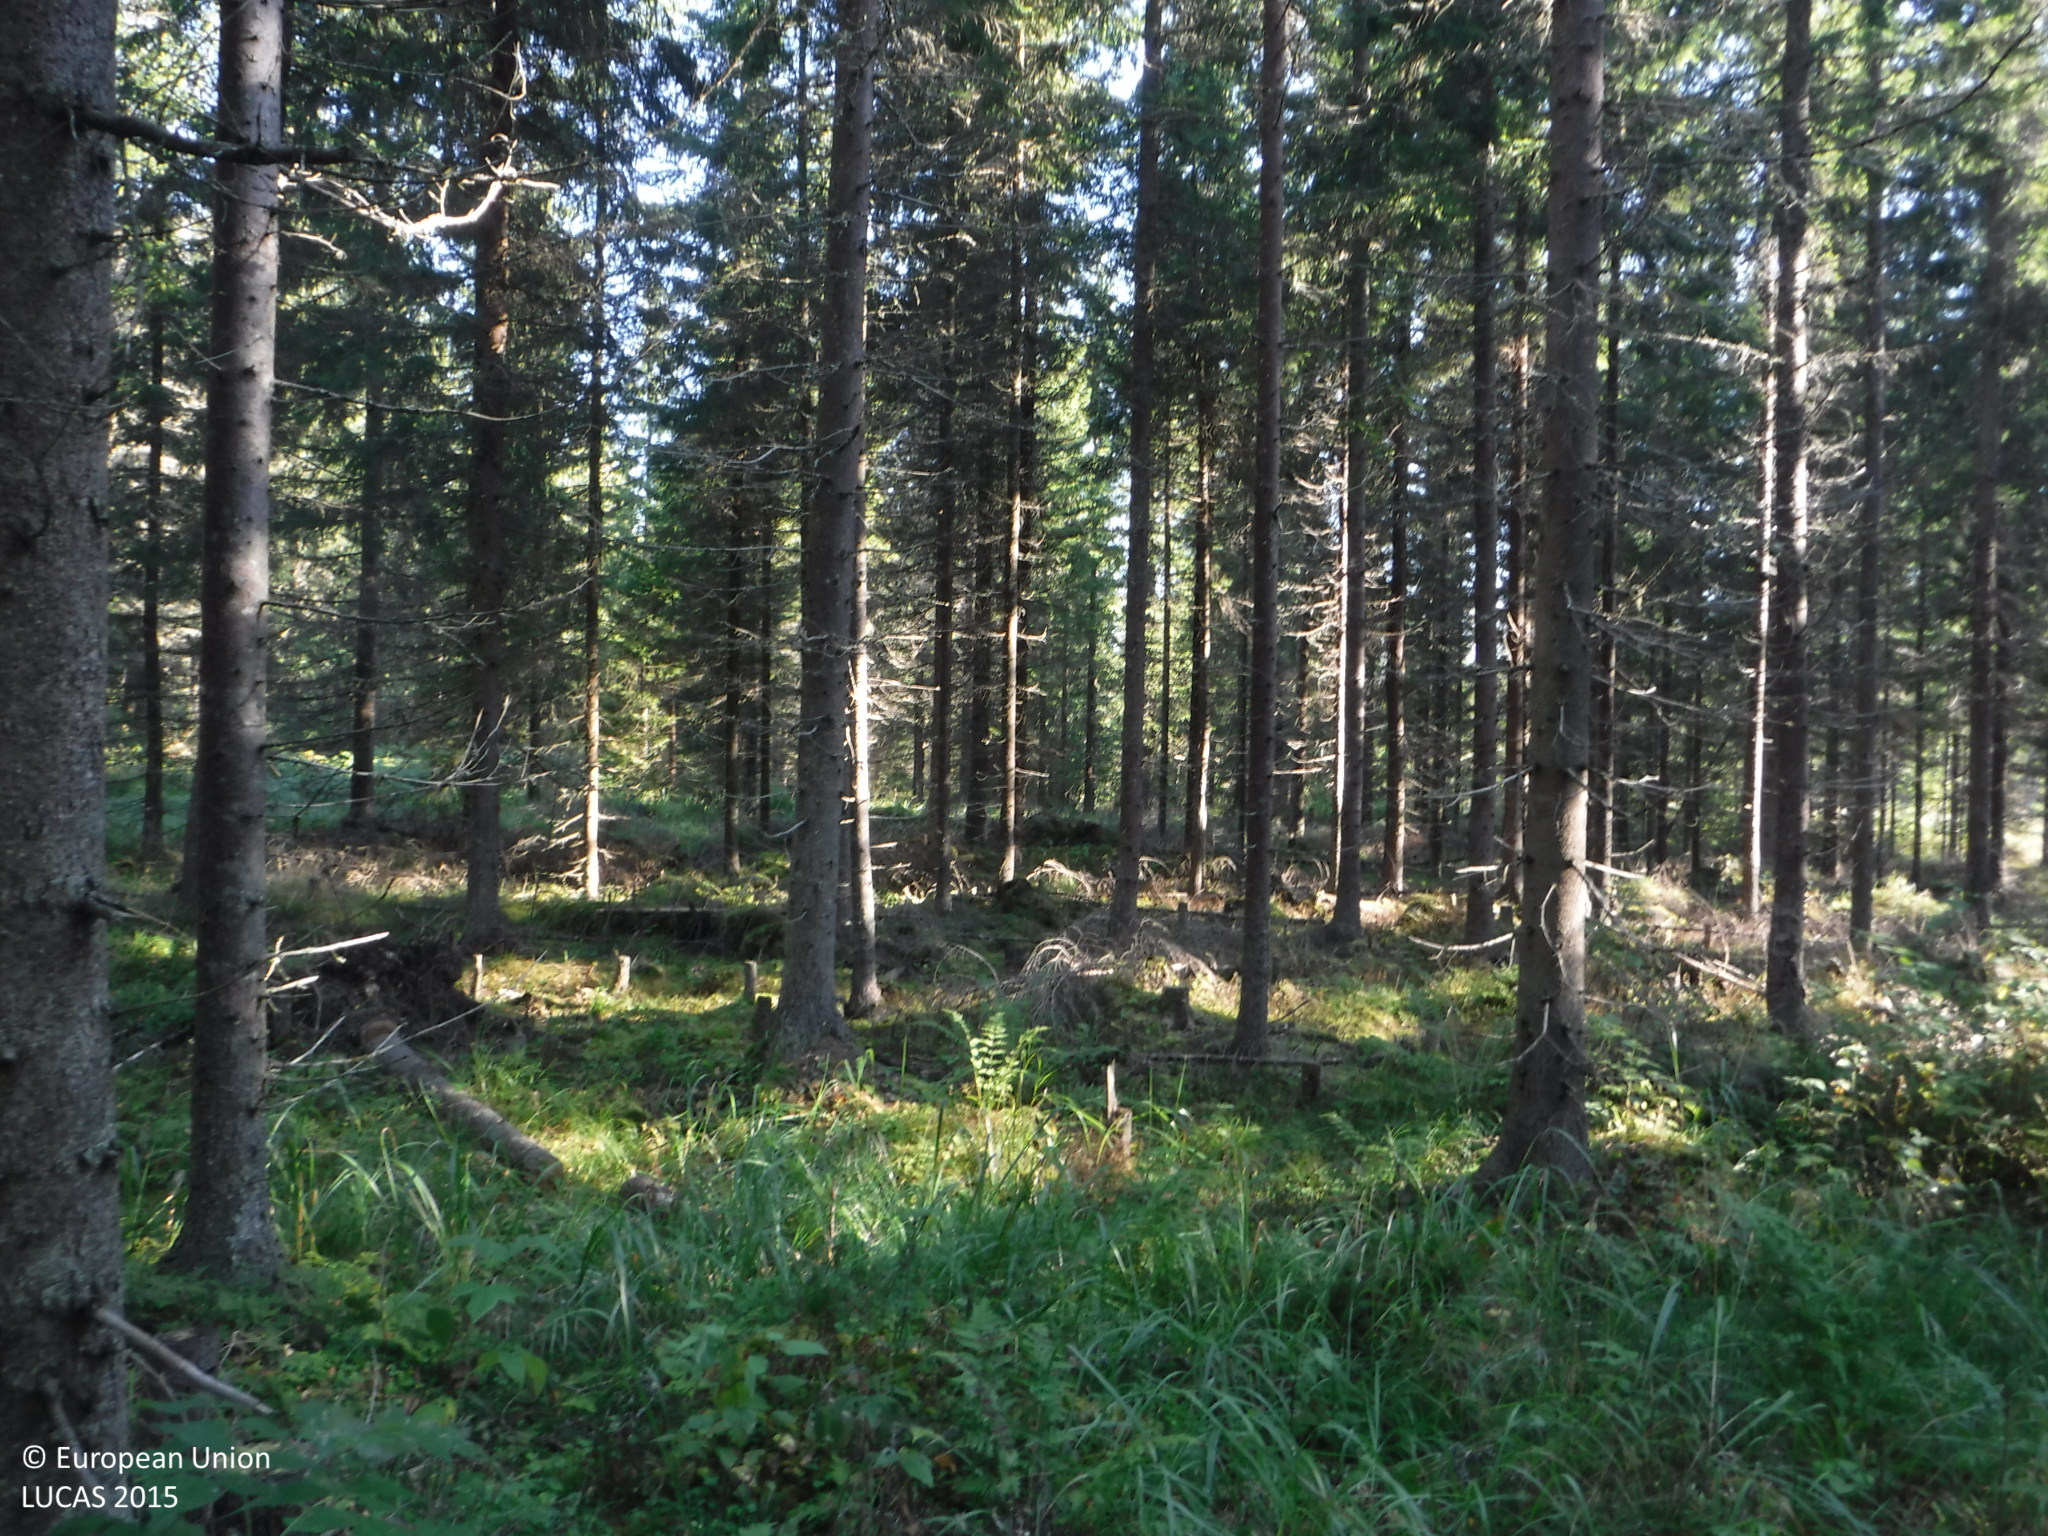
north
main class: Woodland
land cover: Spruce dominated coniferous woodland
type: boreal forest
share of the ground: 50 - 75 %
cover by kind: coniferous forest trees 50 %, herbaceous plants 30 %, shrubs 10 %, lichens and mosses 10 %
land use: Forestry
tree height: > 5 m
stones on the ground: < 10 %
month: August
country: FI
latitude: 61.2596
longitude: 21.7065
